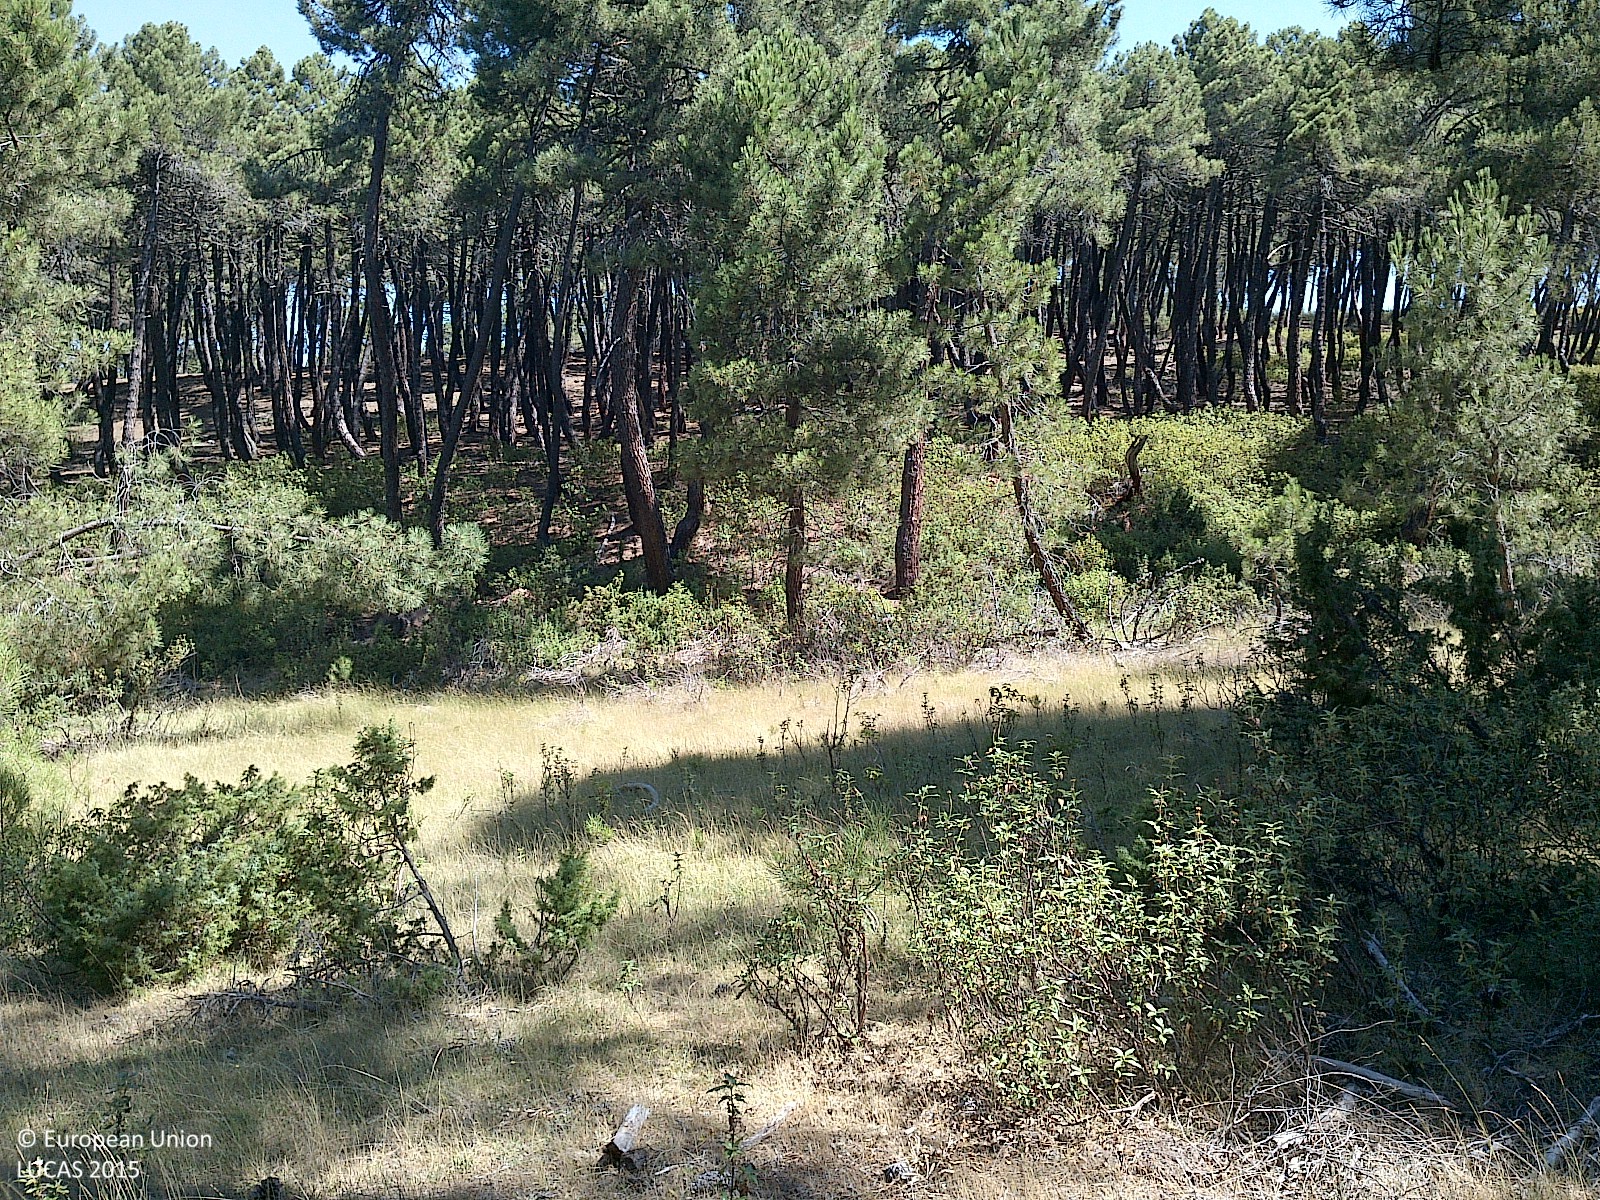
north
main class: Woodland
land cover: Pine dominated coniferous woodland
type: coniferous forest of the mediterranean region
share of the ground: 25 - 50 %
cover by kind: coniferous forest trees 40 %, shrubs 30 %, herbaceous plants 30 %
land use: Forestry
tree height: > 5 m
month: July
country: ES
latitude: 41.7892
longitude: -3.1752
